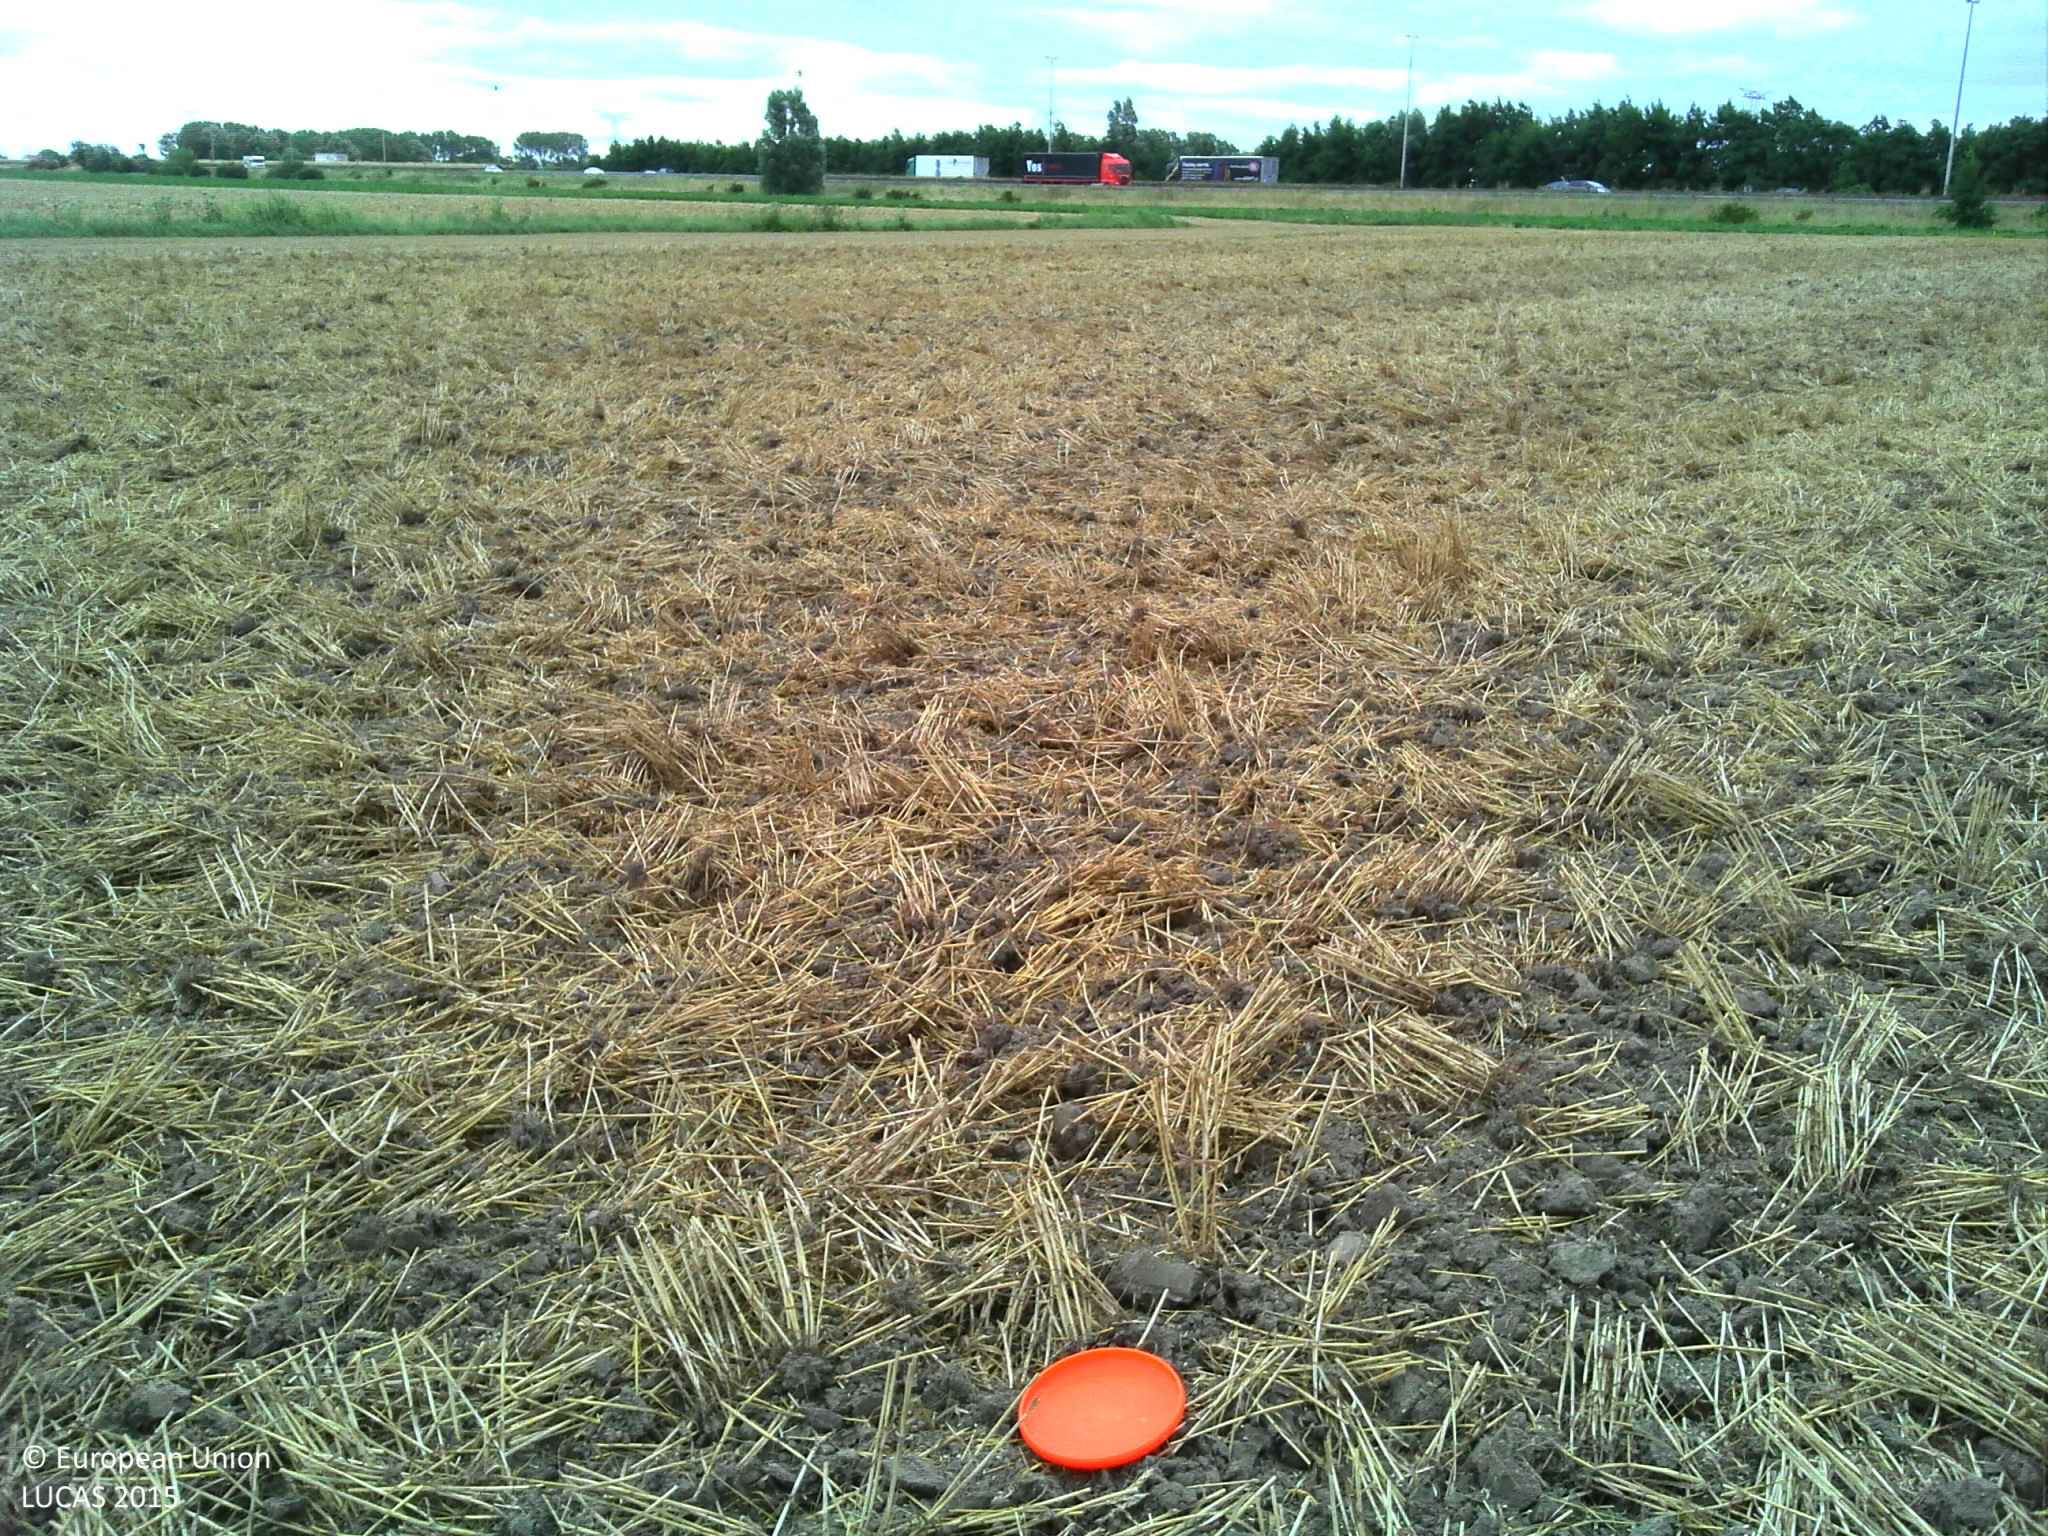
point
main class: Cropland
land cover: Common wheat
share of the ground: 25 - 50 %
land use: Agriculture (excluding fallow land and kitchen gardens)
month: August
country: FR
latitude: 50.9369
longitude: 2.0582
